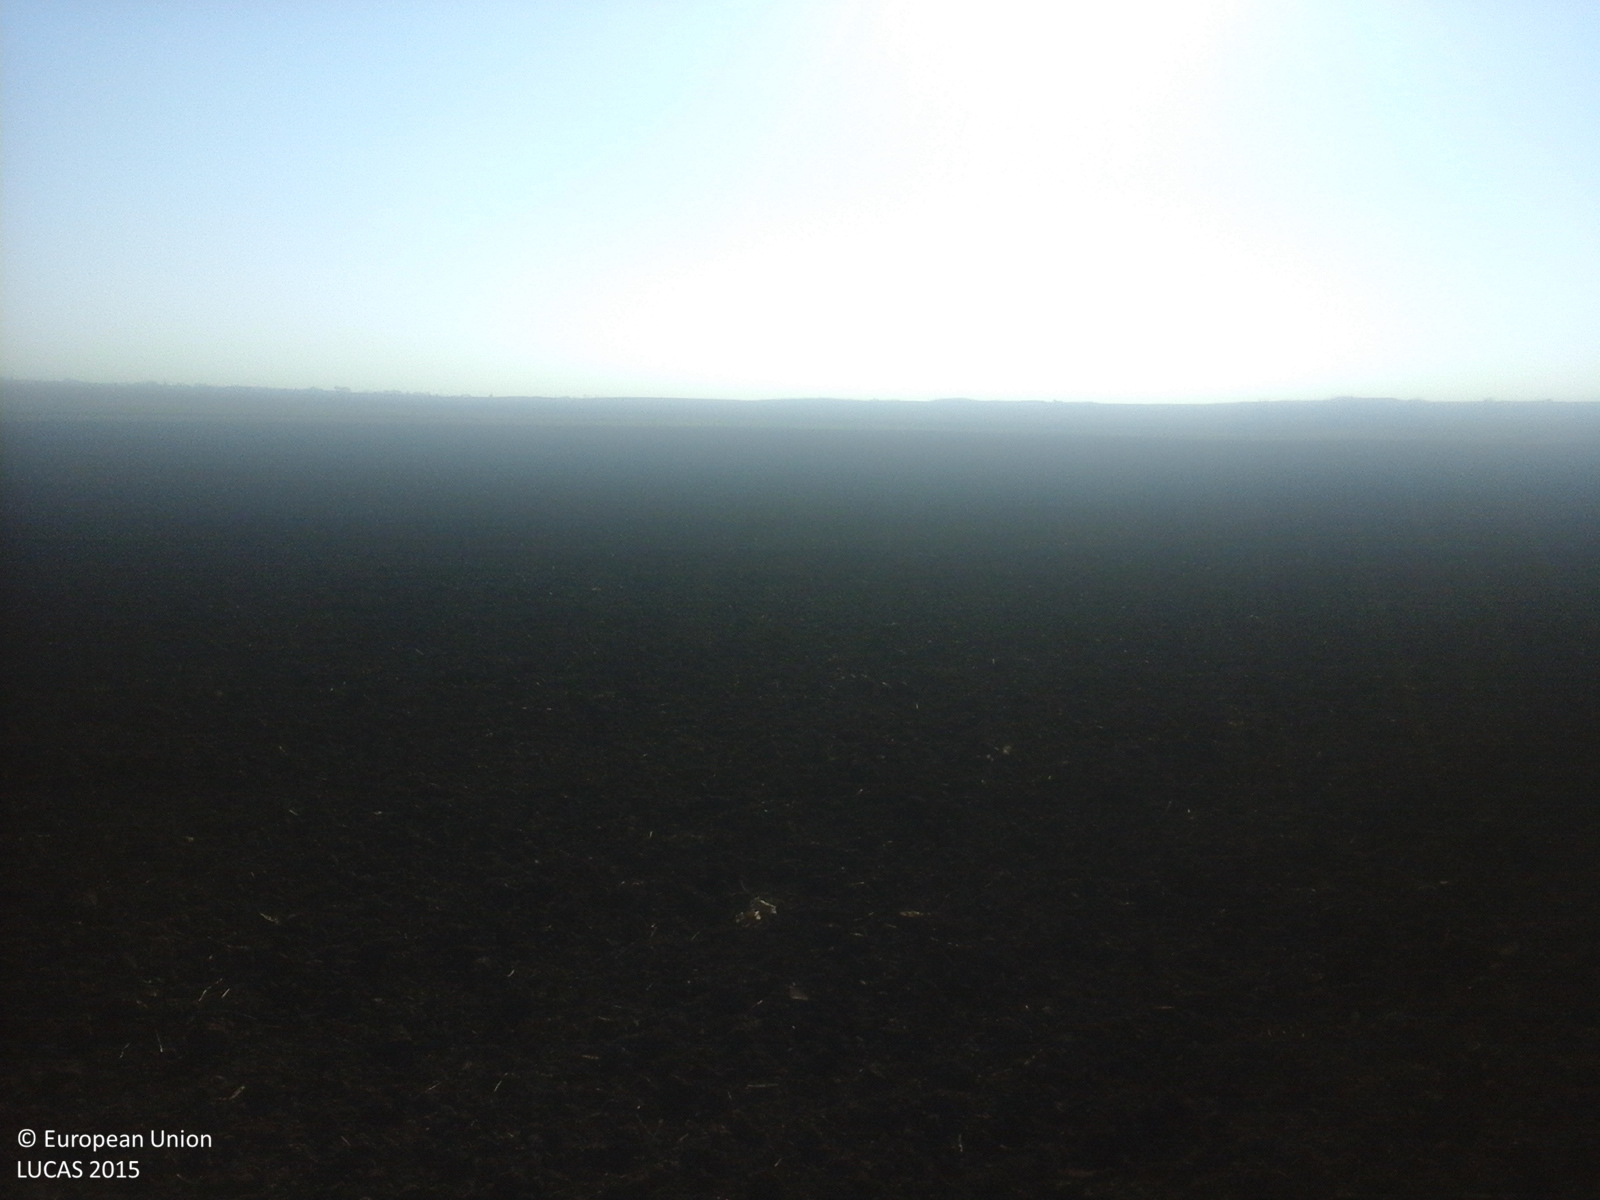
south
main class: Cropland
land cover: Common wheat
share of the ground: < 10 %
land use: Agriculture (excluding fallow land and kitchen gardens)
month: October
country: RO
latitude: 45.8568
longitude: 27.1340
